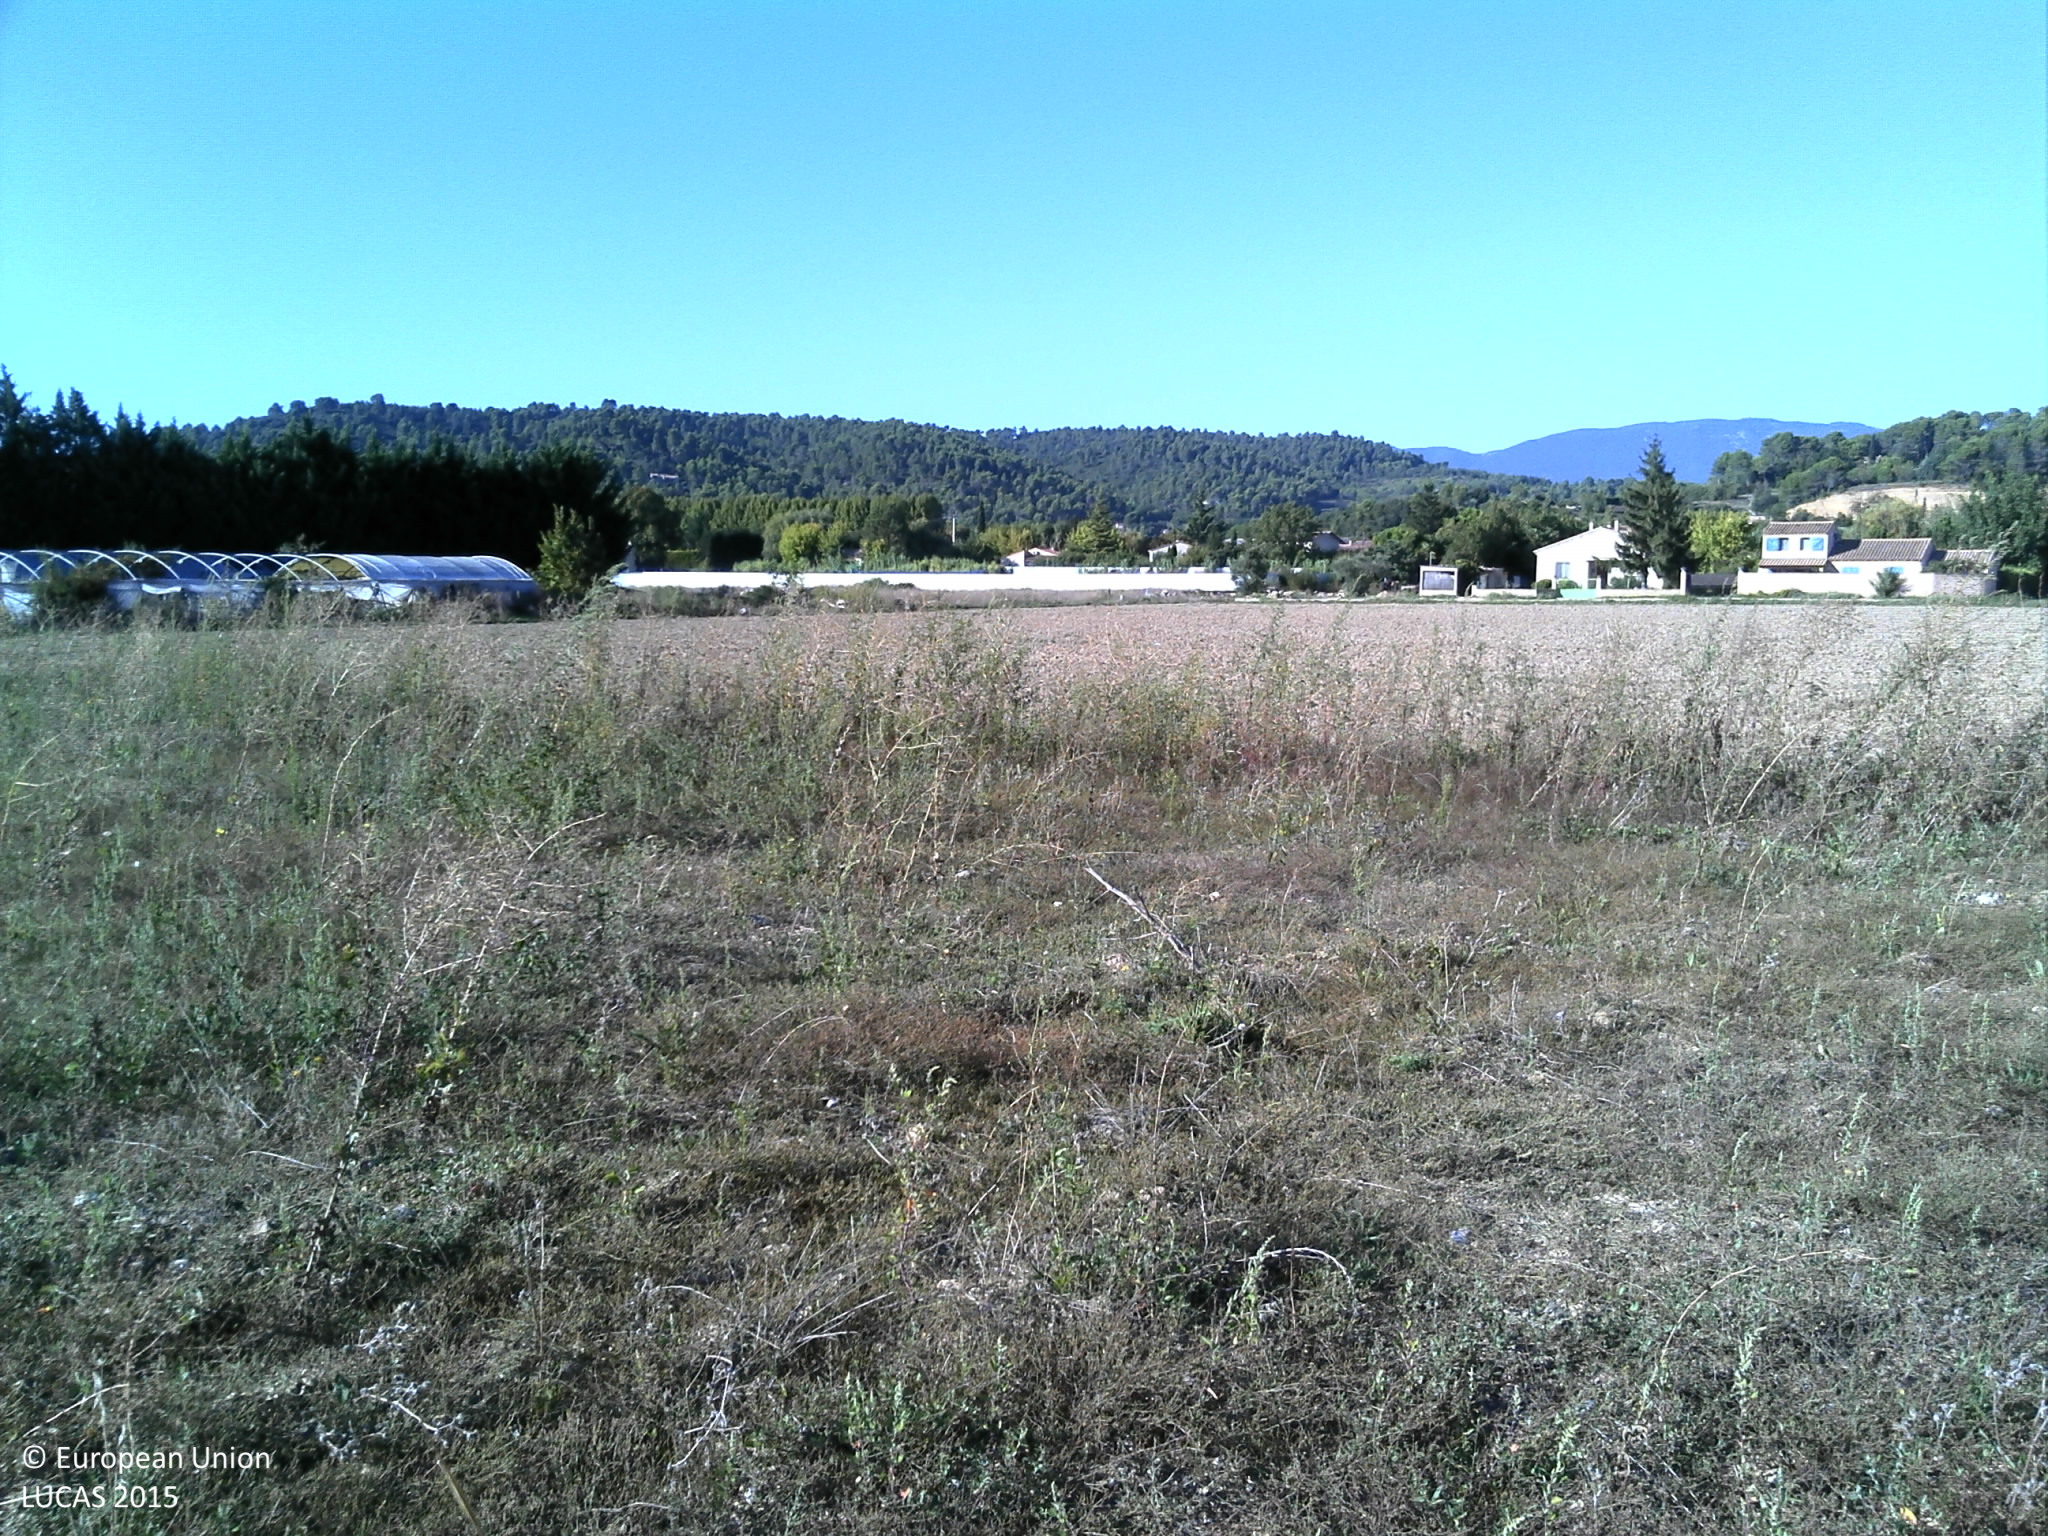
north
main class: Grassland
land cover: Spontaneously vegetated surfaces
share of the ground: > 75 %
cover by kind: herbaceous plants 70 %, unconsolidated bare surface 15 %, consolidated bare surface 10 %, shrubs 5 %
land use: Abandoned areas
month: September
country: FR
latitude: 43.7079
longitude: 5.4298
